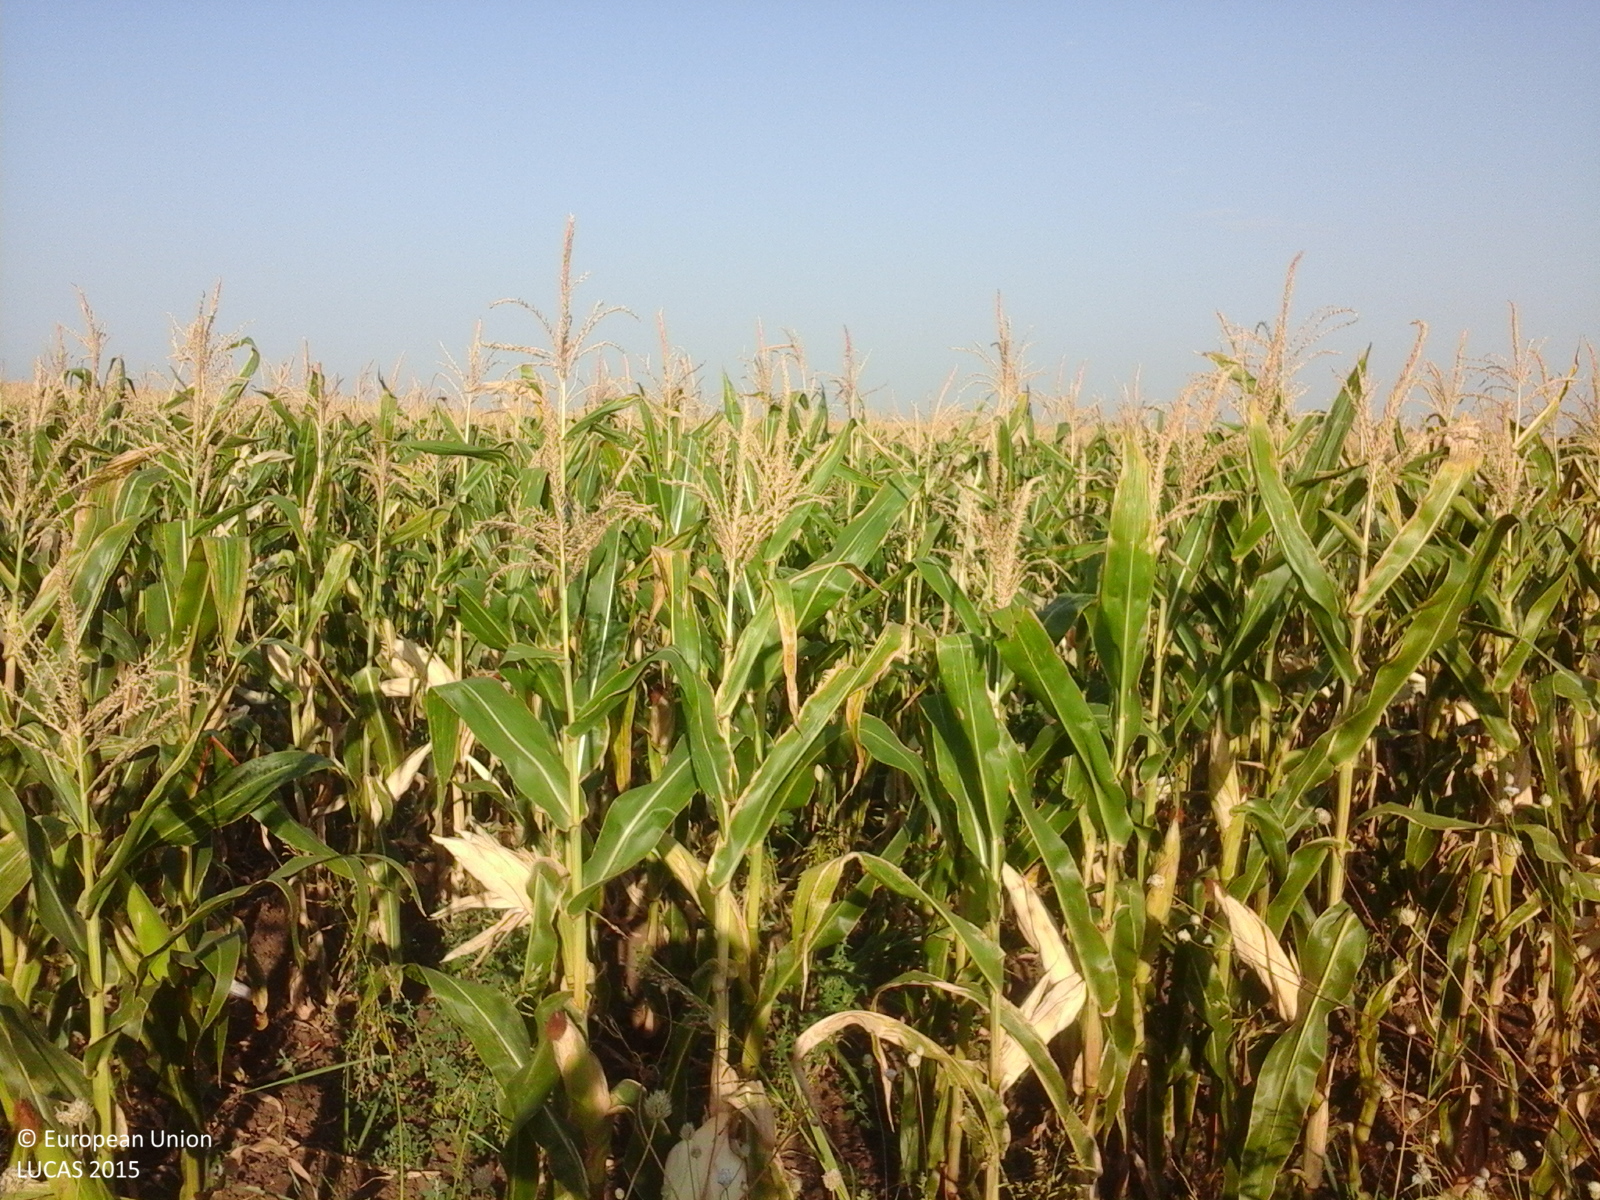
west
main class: Cropland
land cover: Maize
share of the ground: > 75 %
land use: Agriculture (excluding fallow land and kitchen gardens)
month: August
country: RO
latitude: 43.9941
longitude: 23.0732
